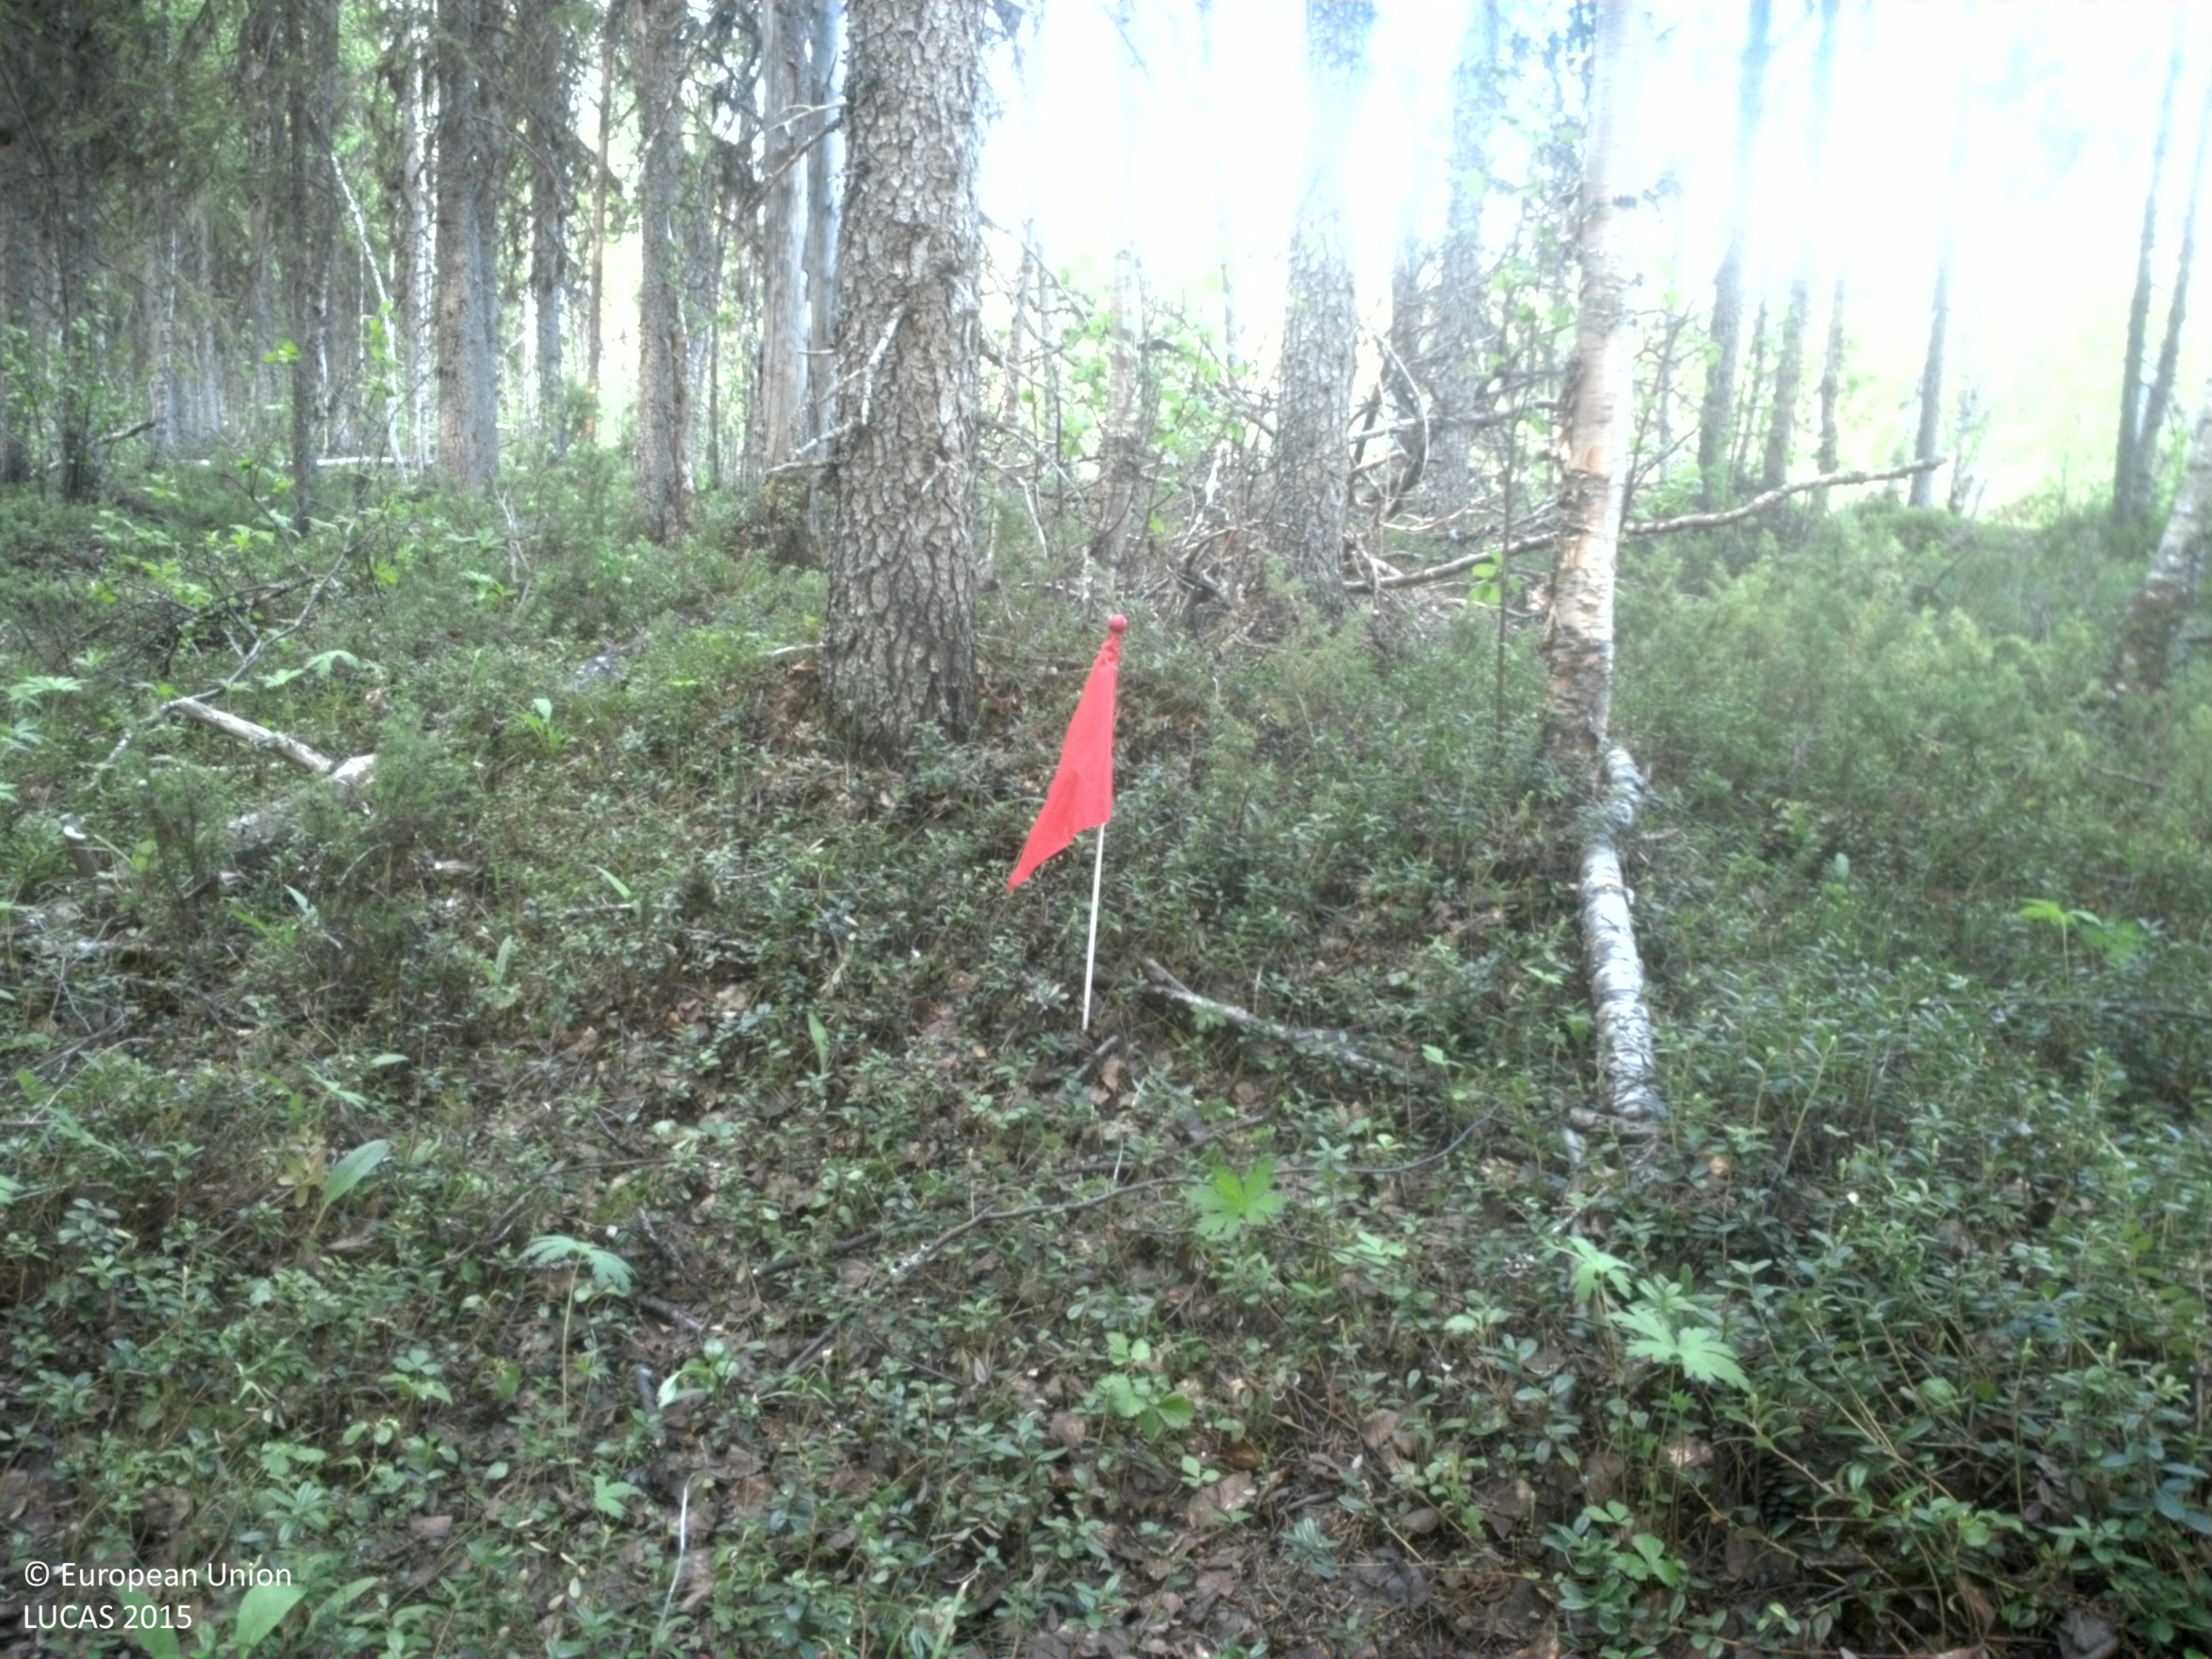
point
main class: Woodland
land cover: Spruce dominated mixed woodland
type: boreal forest
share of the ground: 50 - 75 %
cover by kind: shrubs 45 %, coniferous forest trees 35 %, broadleaved forest trees 15 %, herbaceous plants 5 %
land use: Forestry
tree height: > 5 m
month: June
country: SE
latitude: 67.0991
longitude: 21.6777
